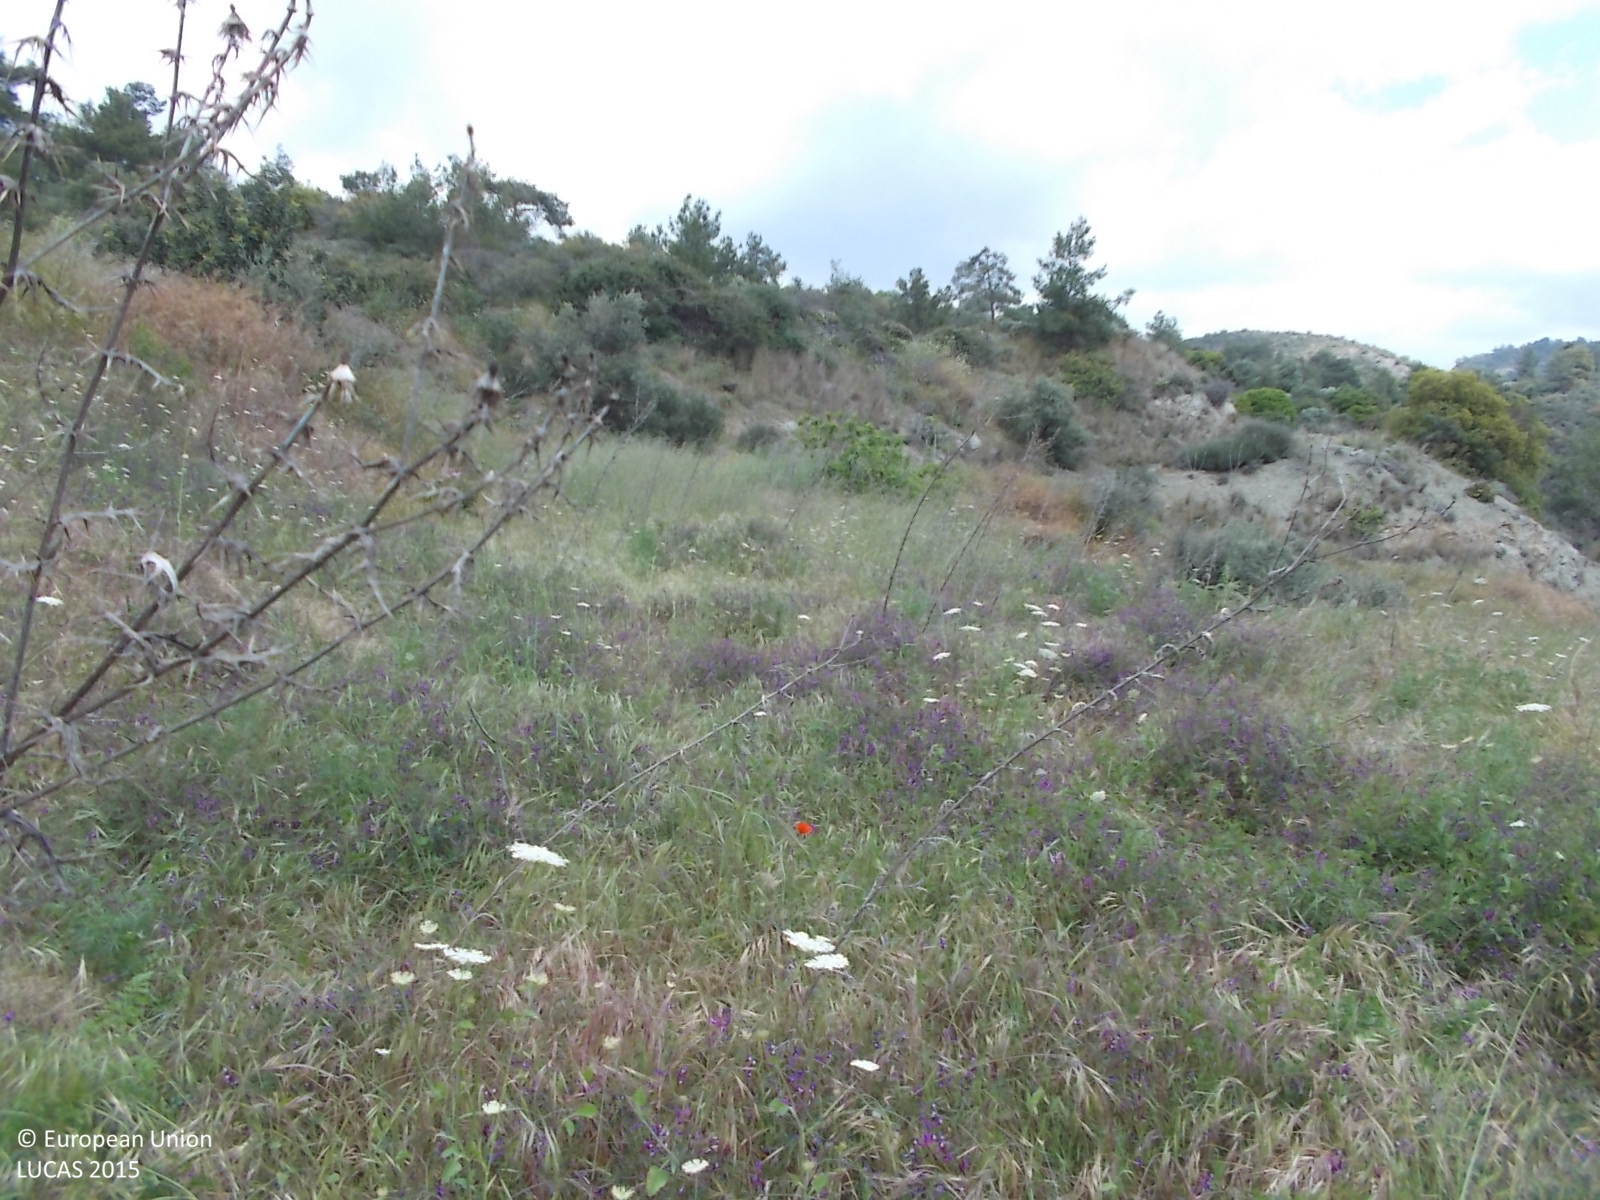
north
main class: Grassland
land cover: Spontaneously vegetated surfaces
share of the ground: > 75 %
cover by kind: herbaceous plants 100 %
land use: Fallow land
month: April
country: CY
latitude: 34.7966
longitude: 33.1358
